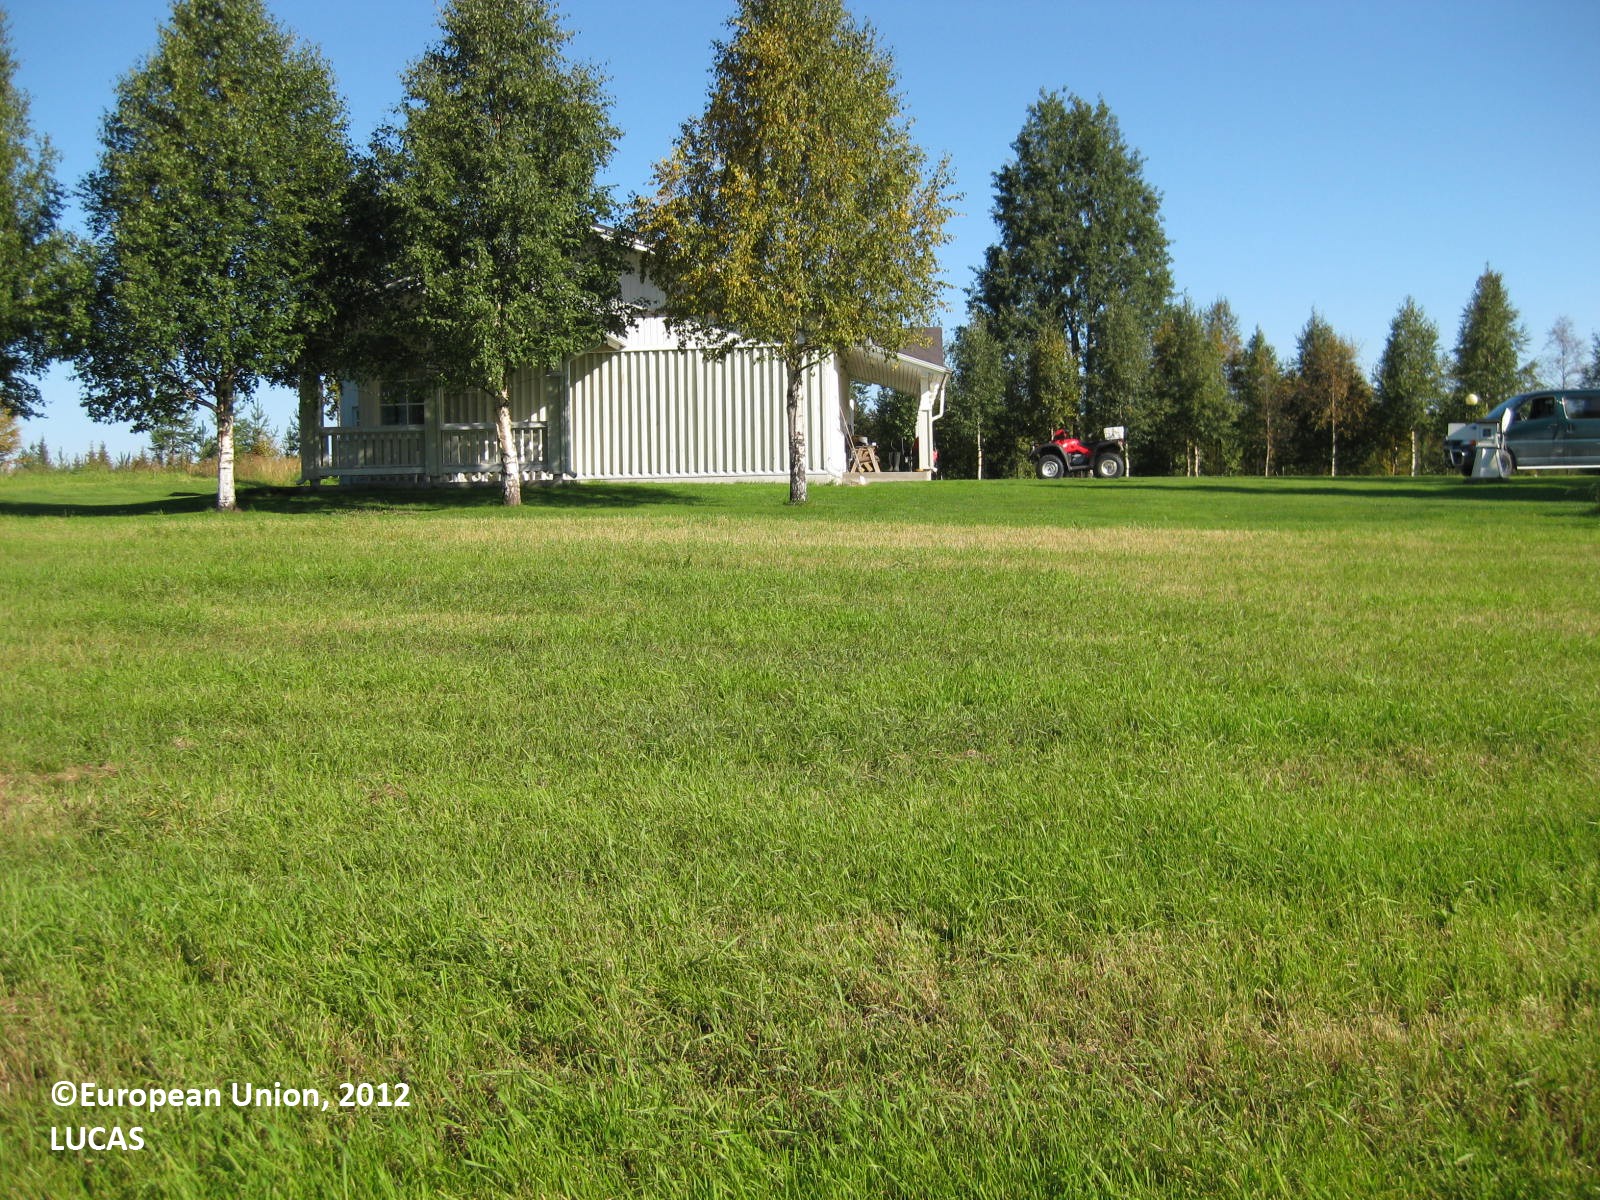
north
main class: Cropland
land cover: Temporary grasslands
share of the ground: > 75 %
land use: Agriculture (excluding fallow land and kitchen gardens)
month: August
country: FI
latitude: 66.0815
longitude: 29.6230
